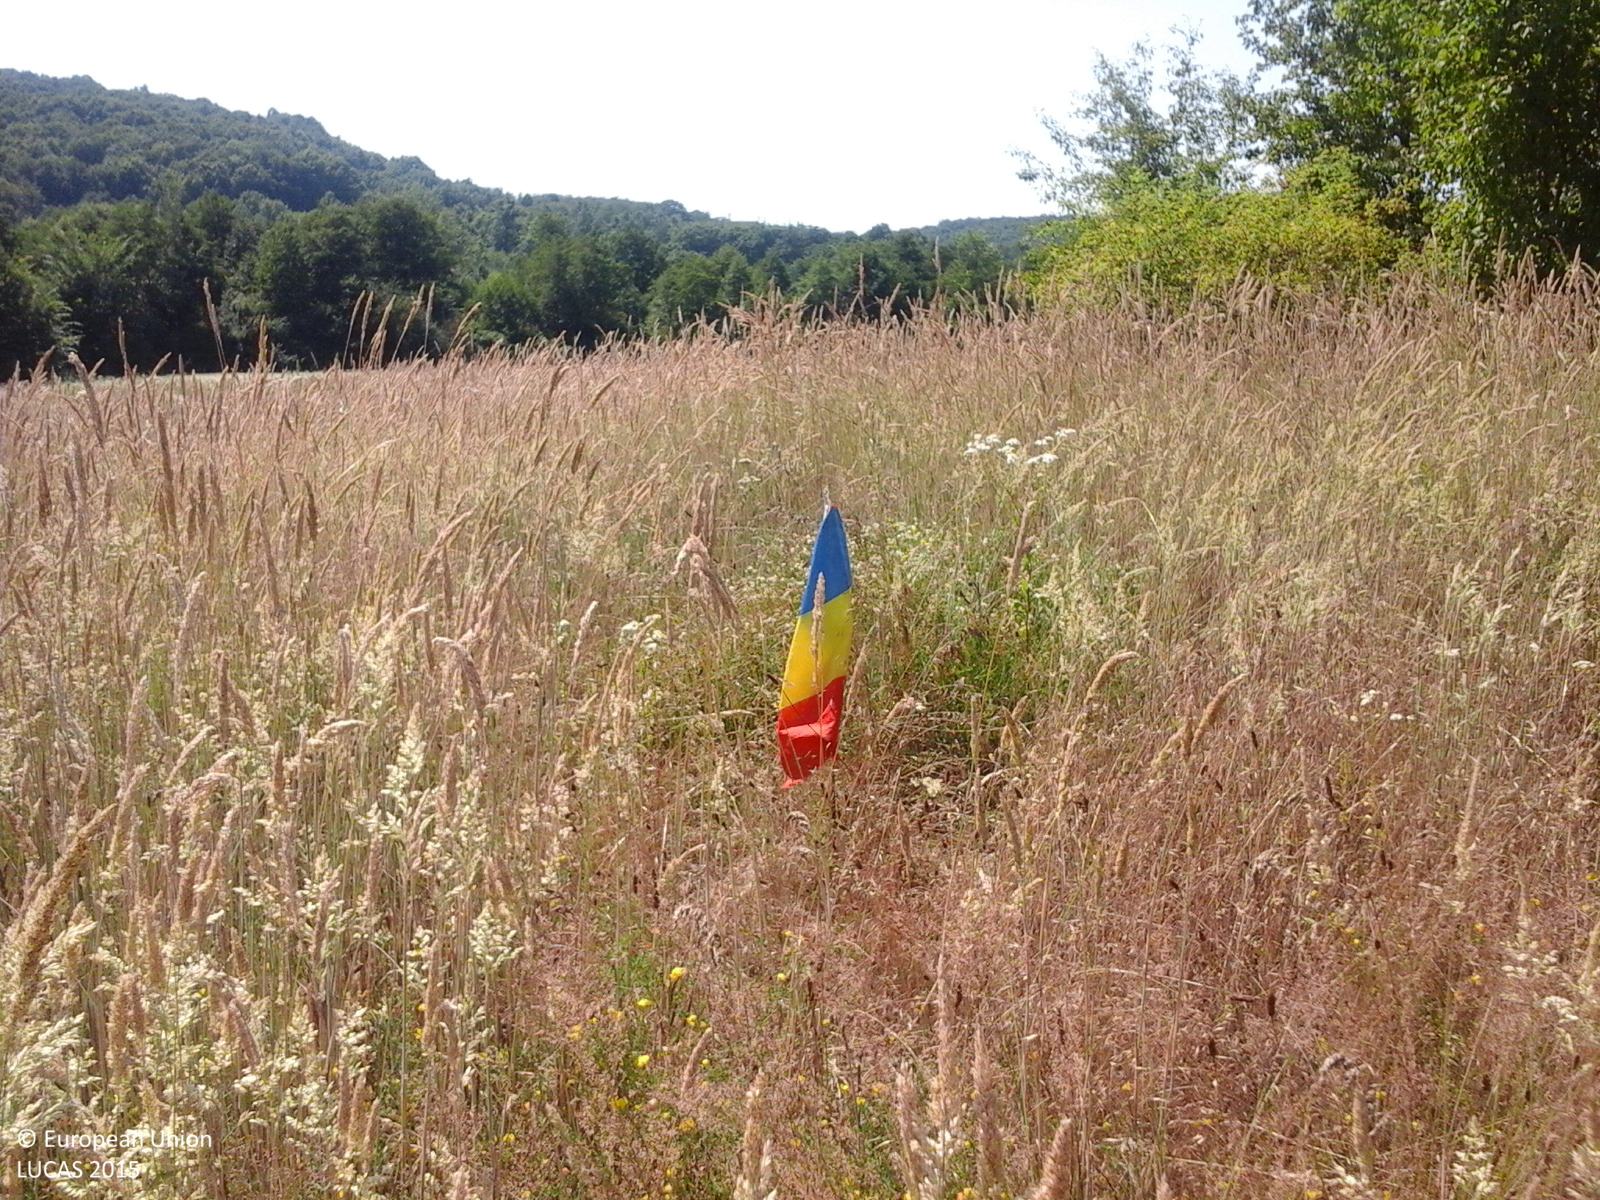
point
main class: Grassland
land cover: Grassland without tree/shrub cover
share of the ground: > 75 %
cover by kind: herbaceous plants 100 %
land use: Agriculture (excluding fallow land and kitchen gardens)
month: July
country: RO
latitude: 44.8821
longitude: 24.6231
